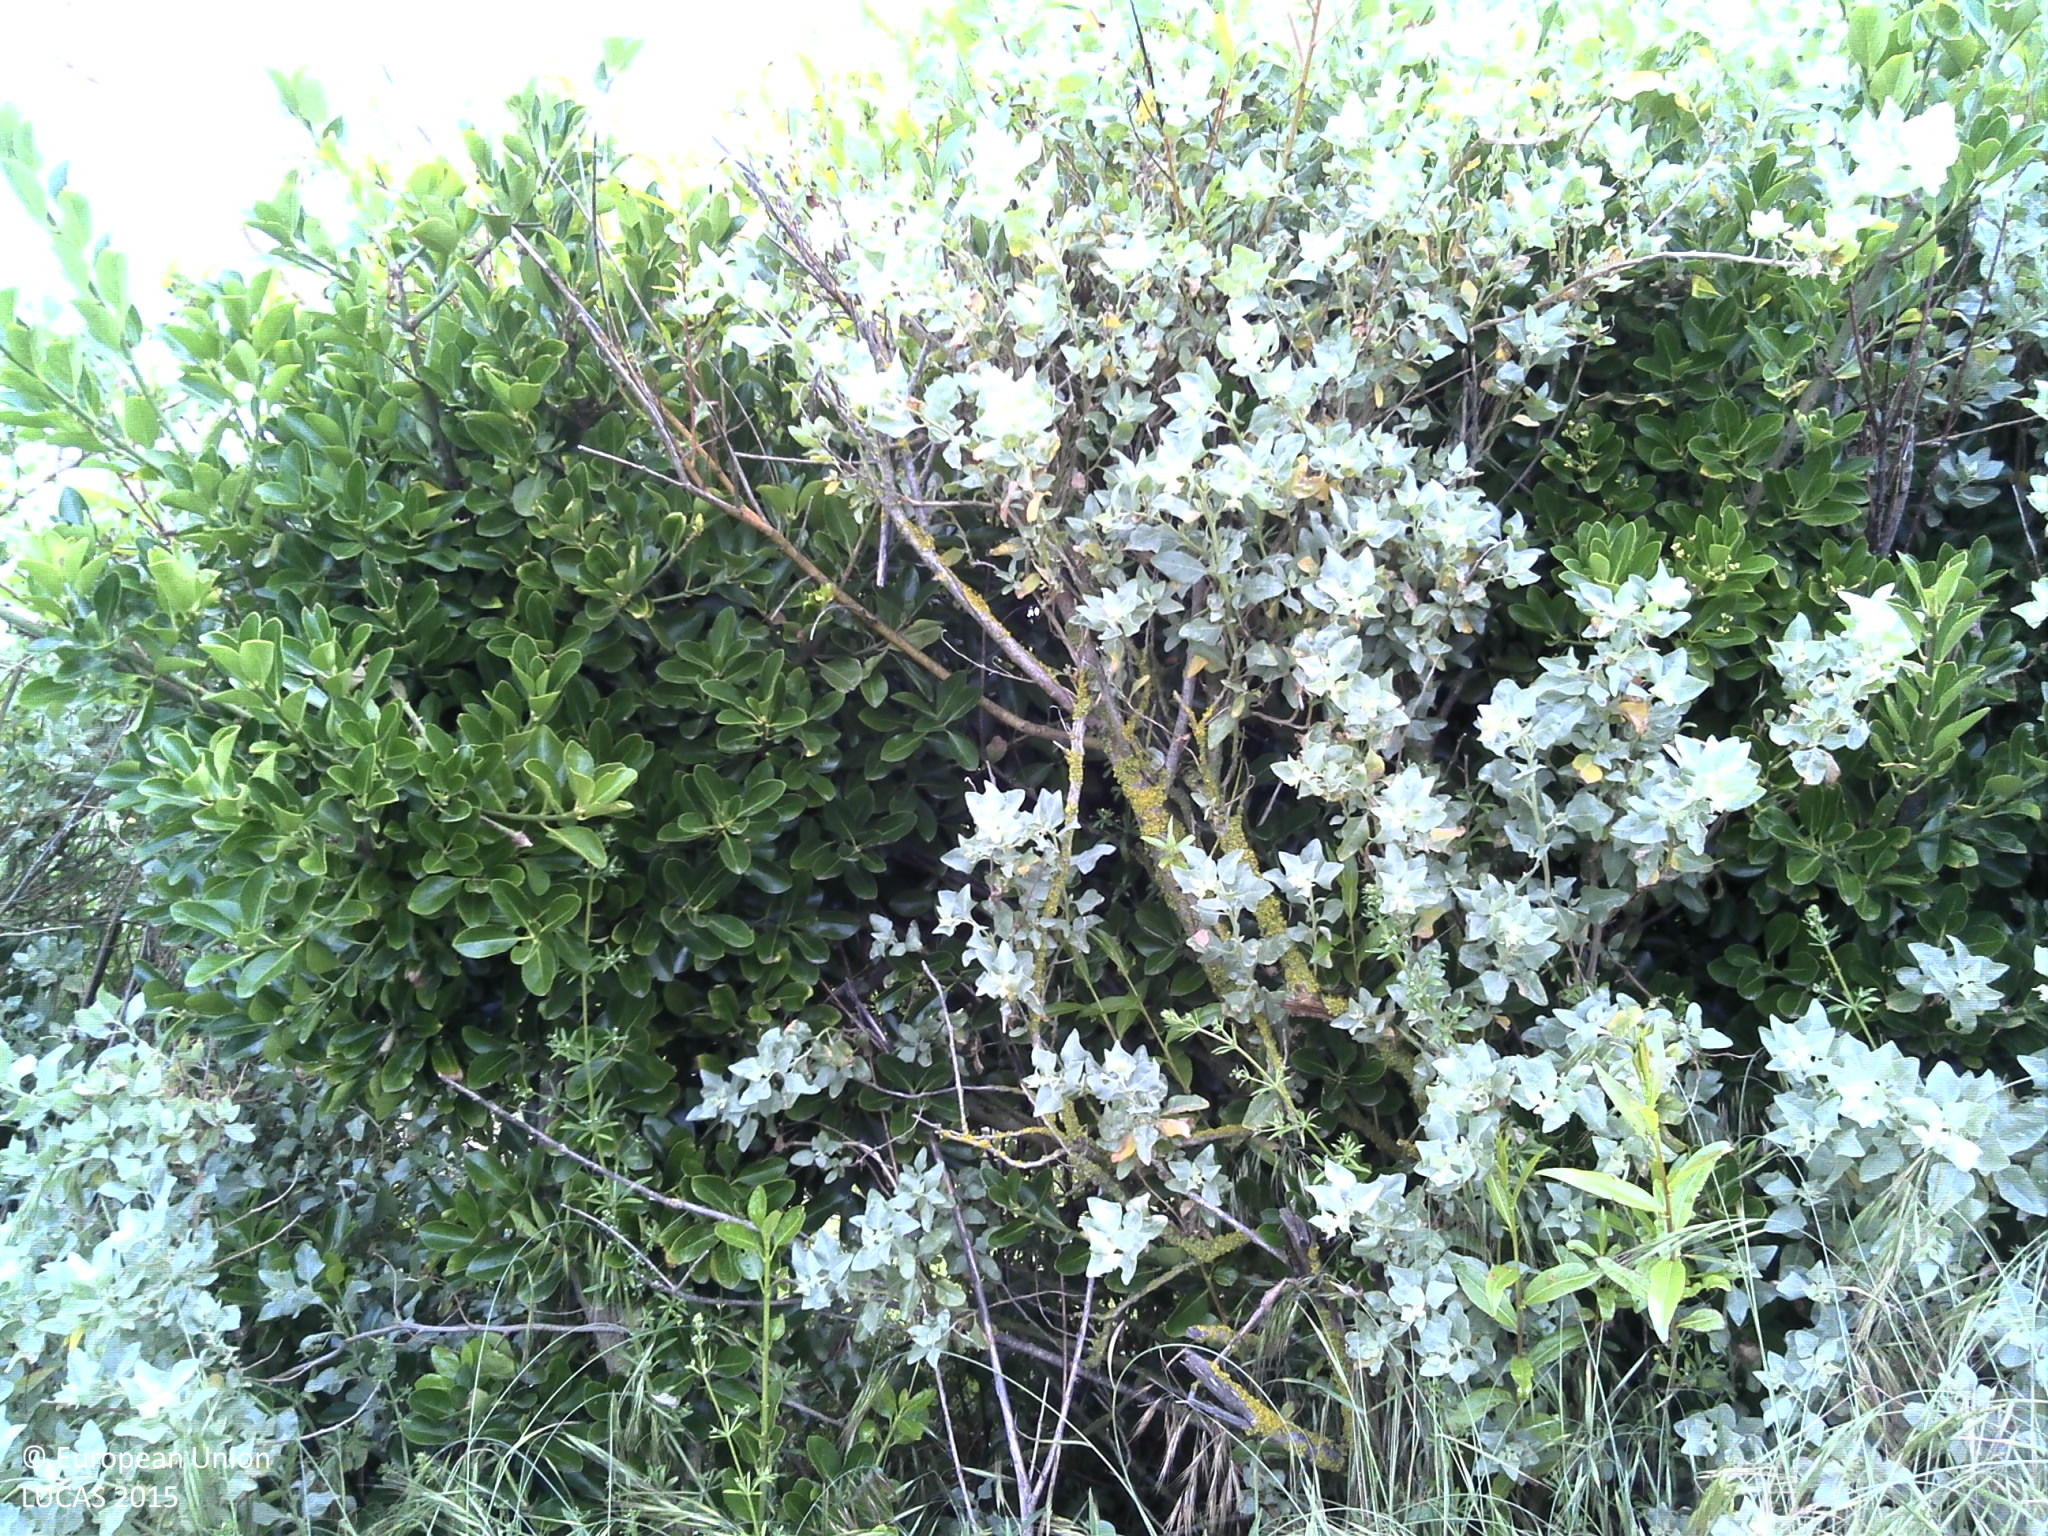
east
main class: Cropland
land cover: Floriculture and ornamental plants
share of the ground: > 75 %
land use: Agriculture (excluding fallow land and kitchen gardens)
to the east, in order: Managed hedges; Floriculture and ornamental plants; Ditches and canals; Managed hedges; Grassland without tree/shrub cover; Ditches and canals; Managed hedges; Ditches and canals; Triticale; Managed hedges; Triticale
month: June
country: FR
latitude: 47.8484
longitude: -4.3241
